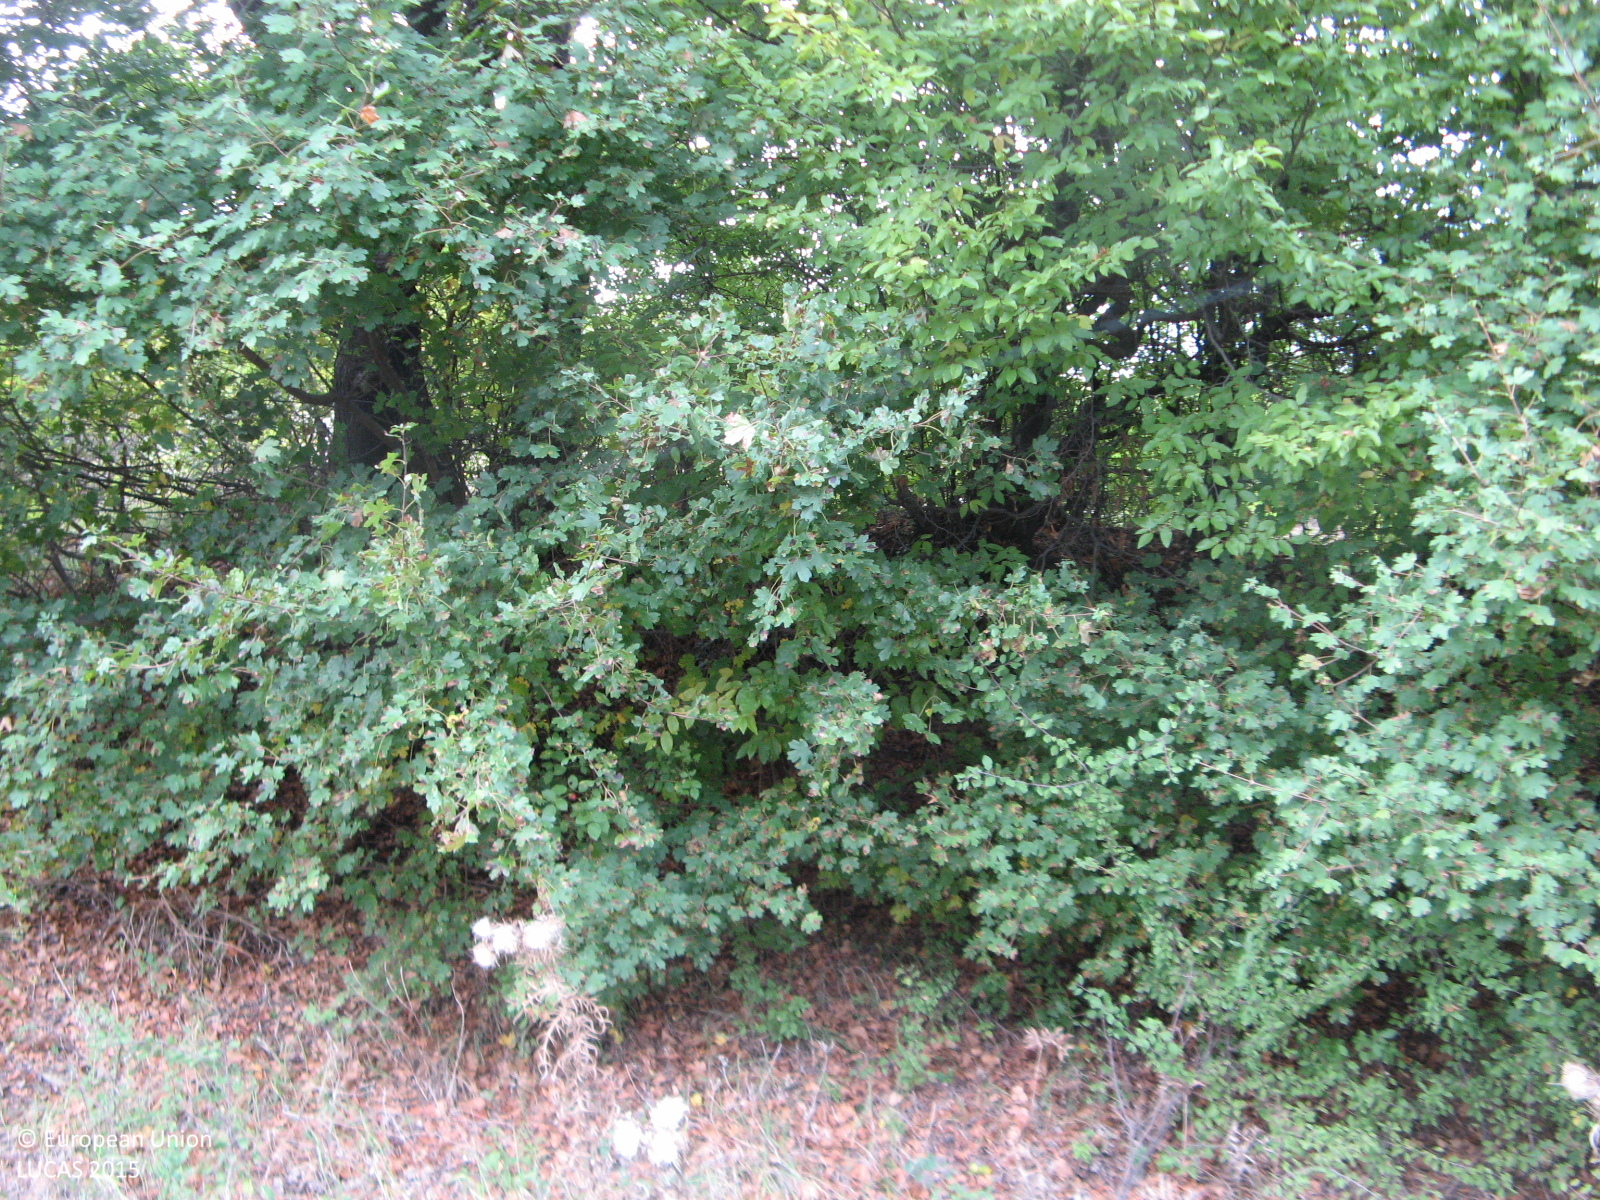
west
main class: Woodland
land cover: Broadleaved woodland
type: thermophilous deciduous forest
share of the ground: > 75 %
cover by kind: broadleaved forest trees 85 %, shrubs 10 %, herbaceous plants 5 %
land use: Semi-natural and natural areas not in use
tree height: > 5 m
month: October
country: BG
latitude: 41.7133
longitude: 25.3577
